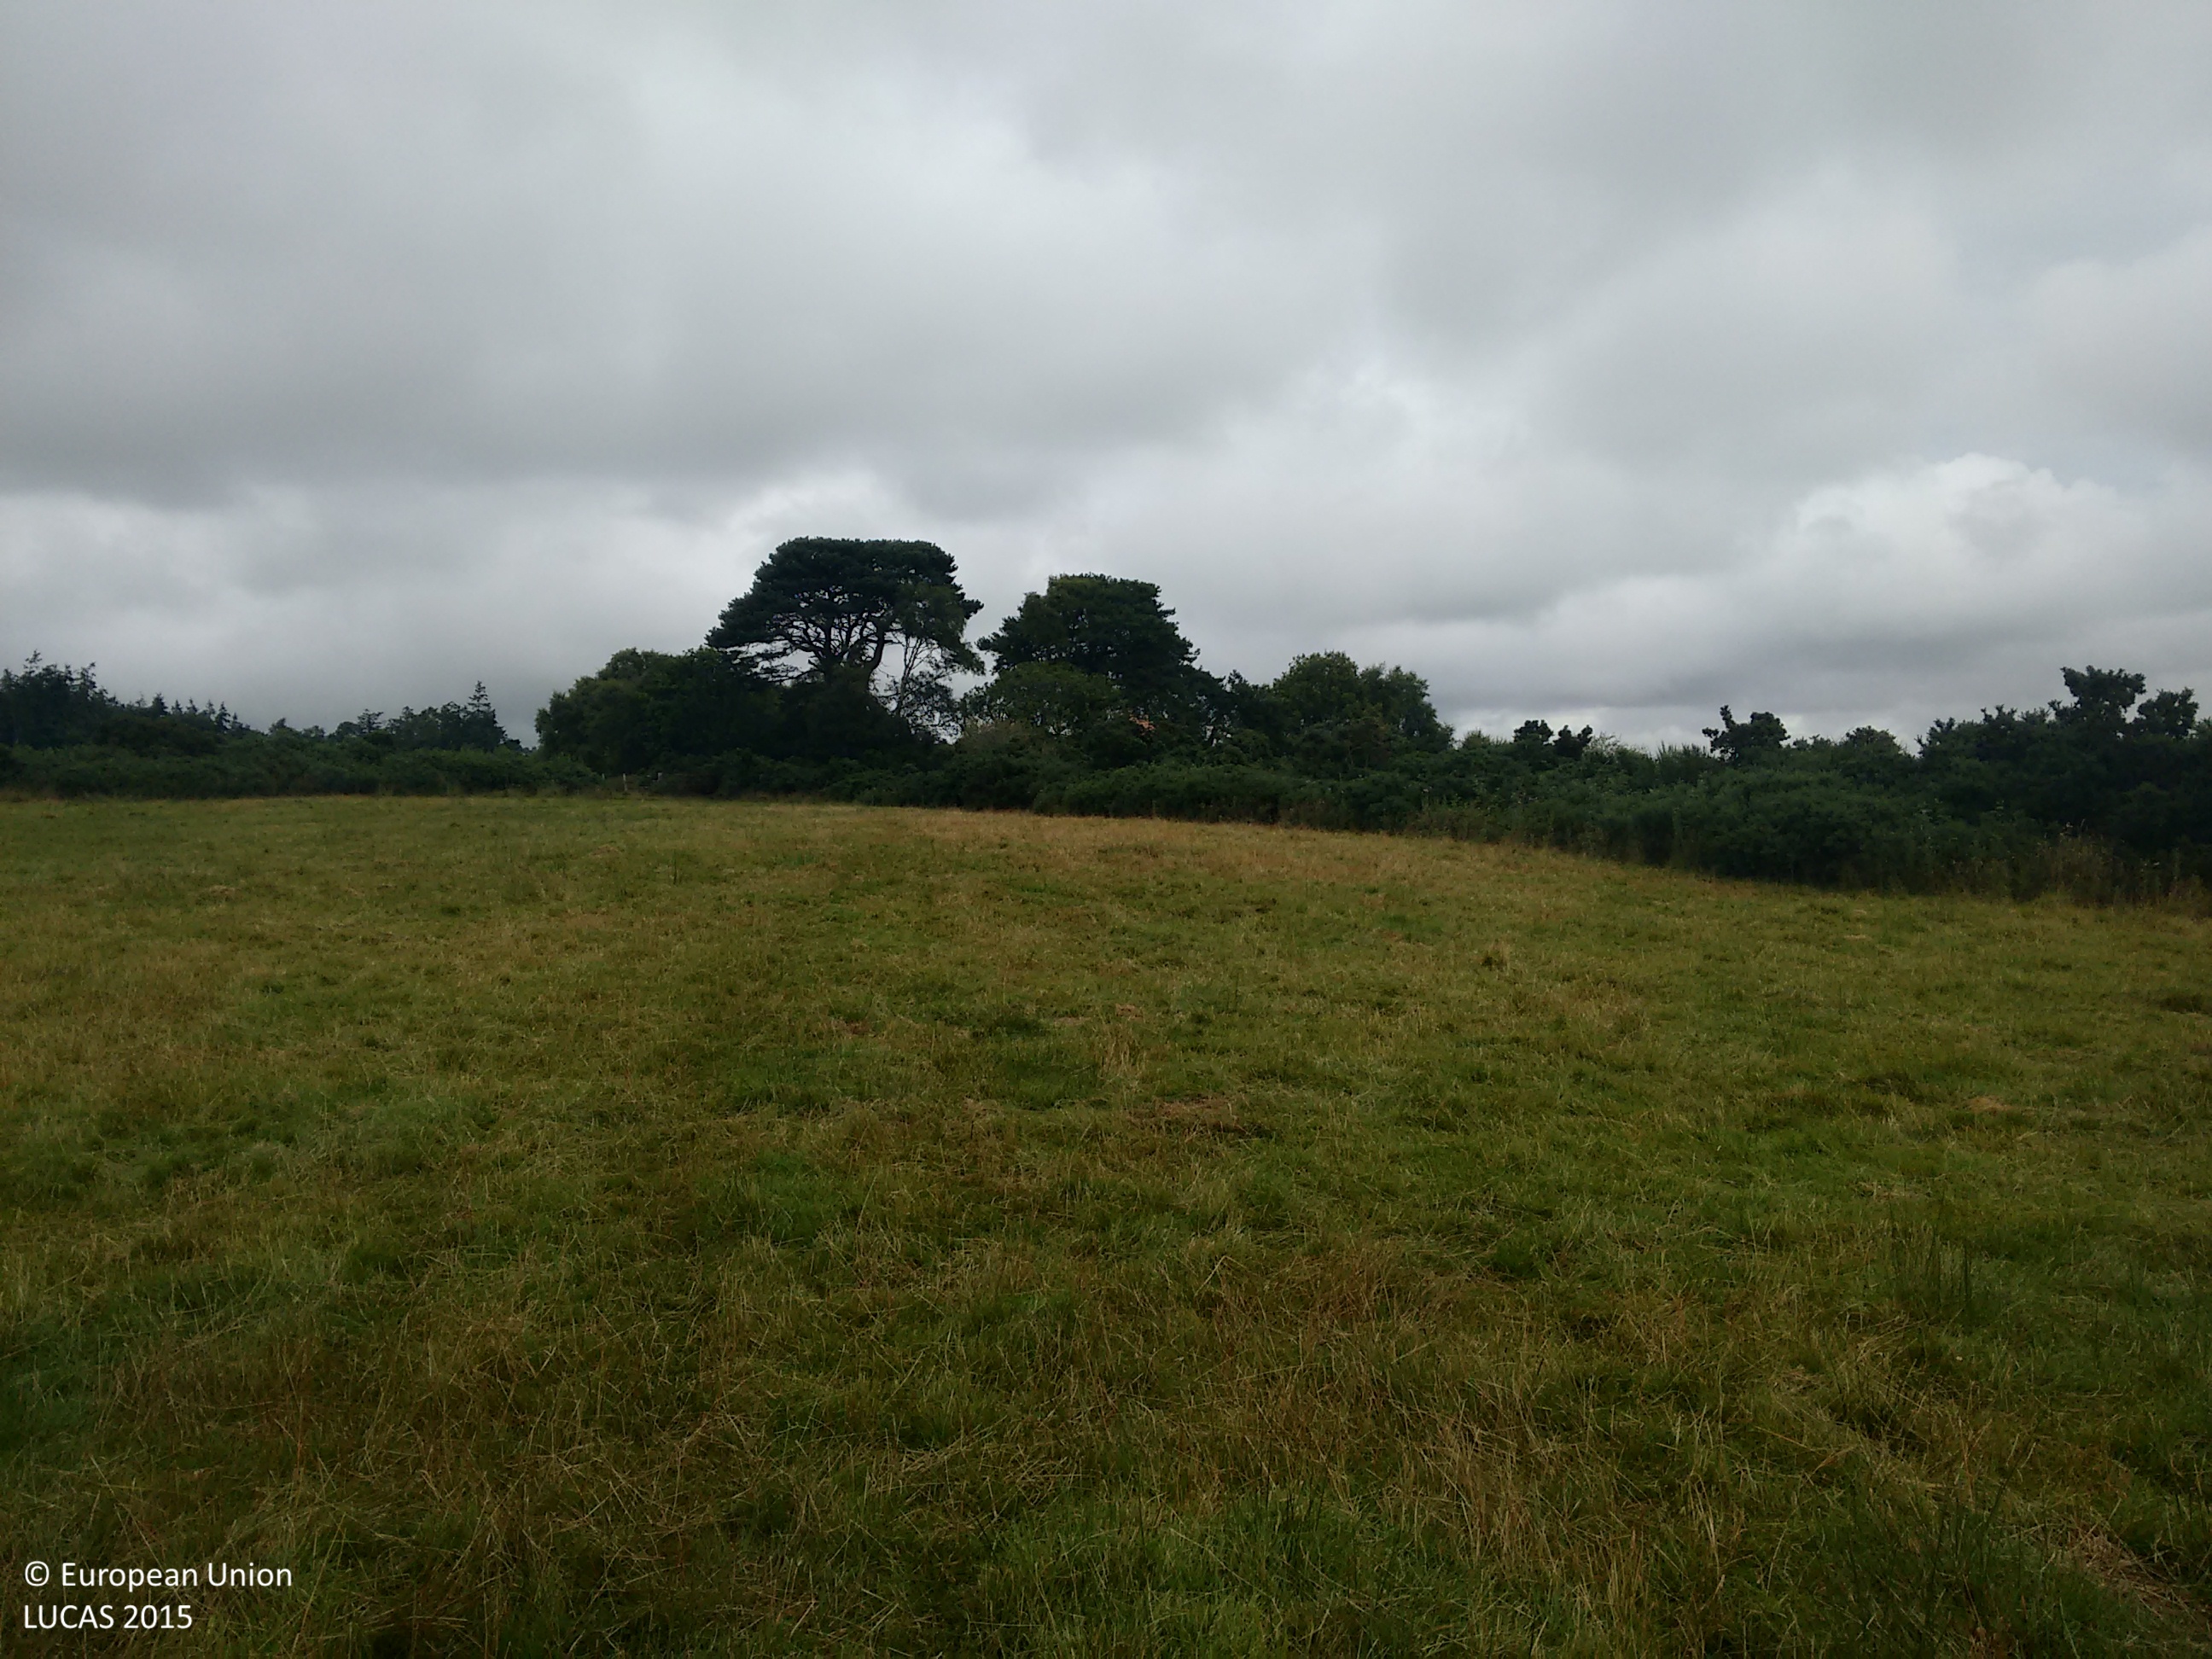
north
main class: Grassland
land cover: Grassland without tree/shrub cover
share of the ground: > 75 %
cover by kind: herbaceous plants 100 %
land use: Agriculture (excluding fallow land and kitchen gardens)
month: August
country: GB
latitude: 57.7867
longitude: -4.0567
